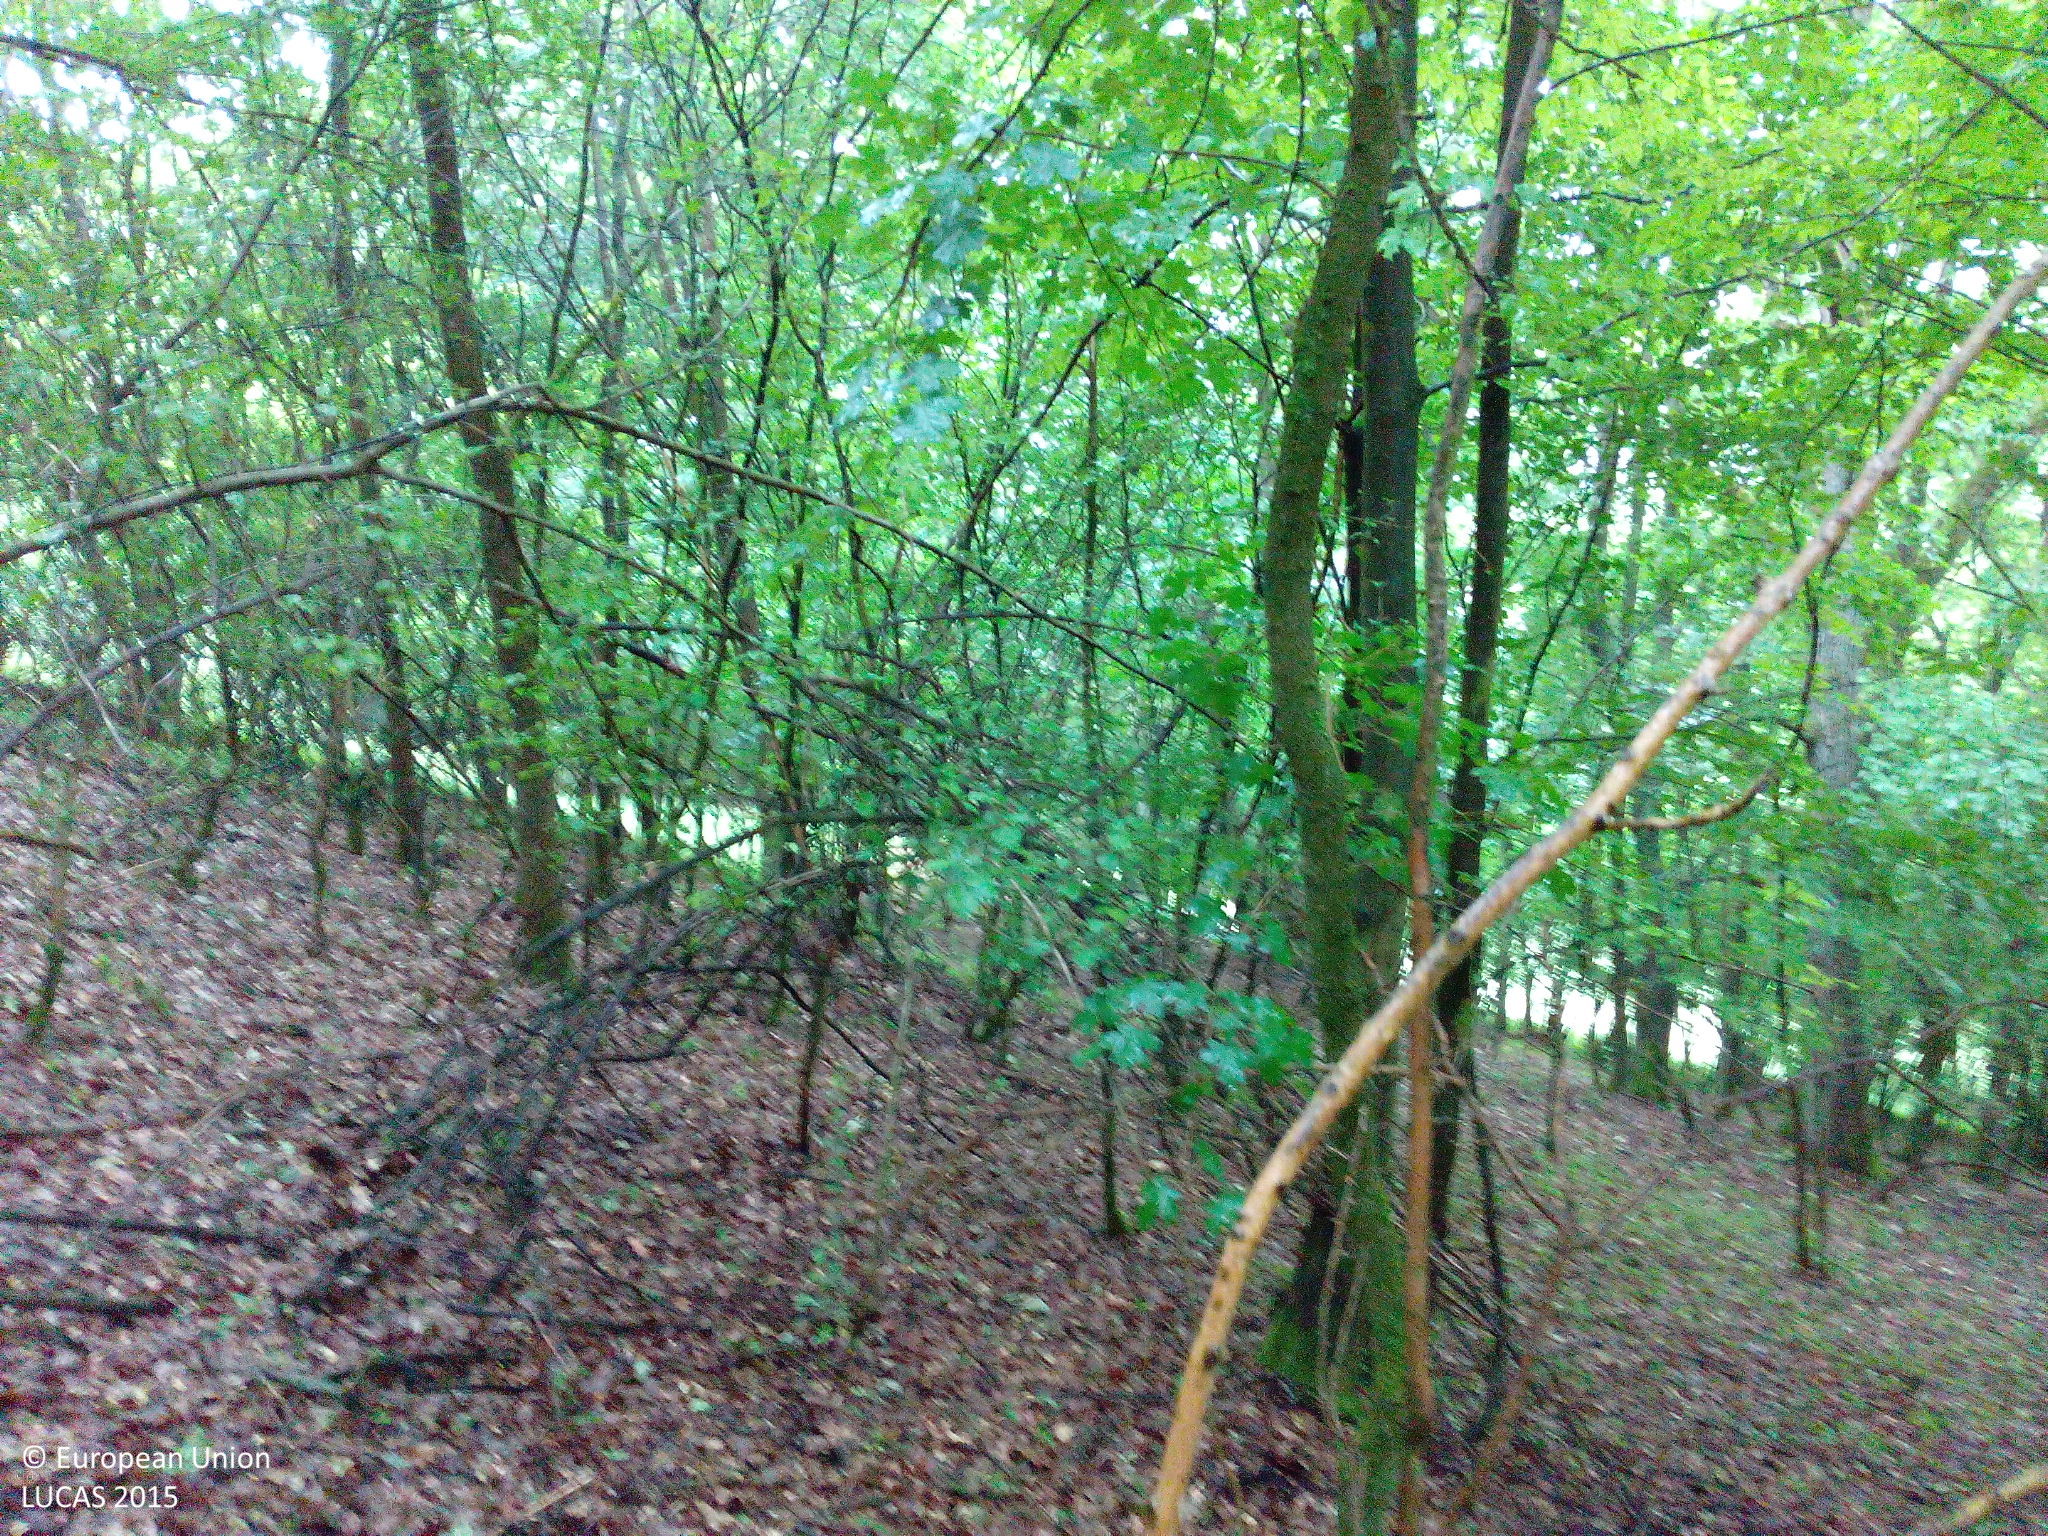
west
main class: Woodland
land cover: Broadleaved woodland
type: mesophytic deciduous forest
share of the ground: > 75 %
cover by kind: broadleaved forest trees 90 %, lichens and mosses 5 %, unconsolidated bare surface 5 %
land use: Forestry
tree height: > 5 m
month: June
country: DE
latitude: 50.0838
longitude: 11.5509
